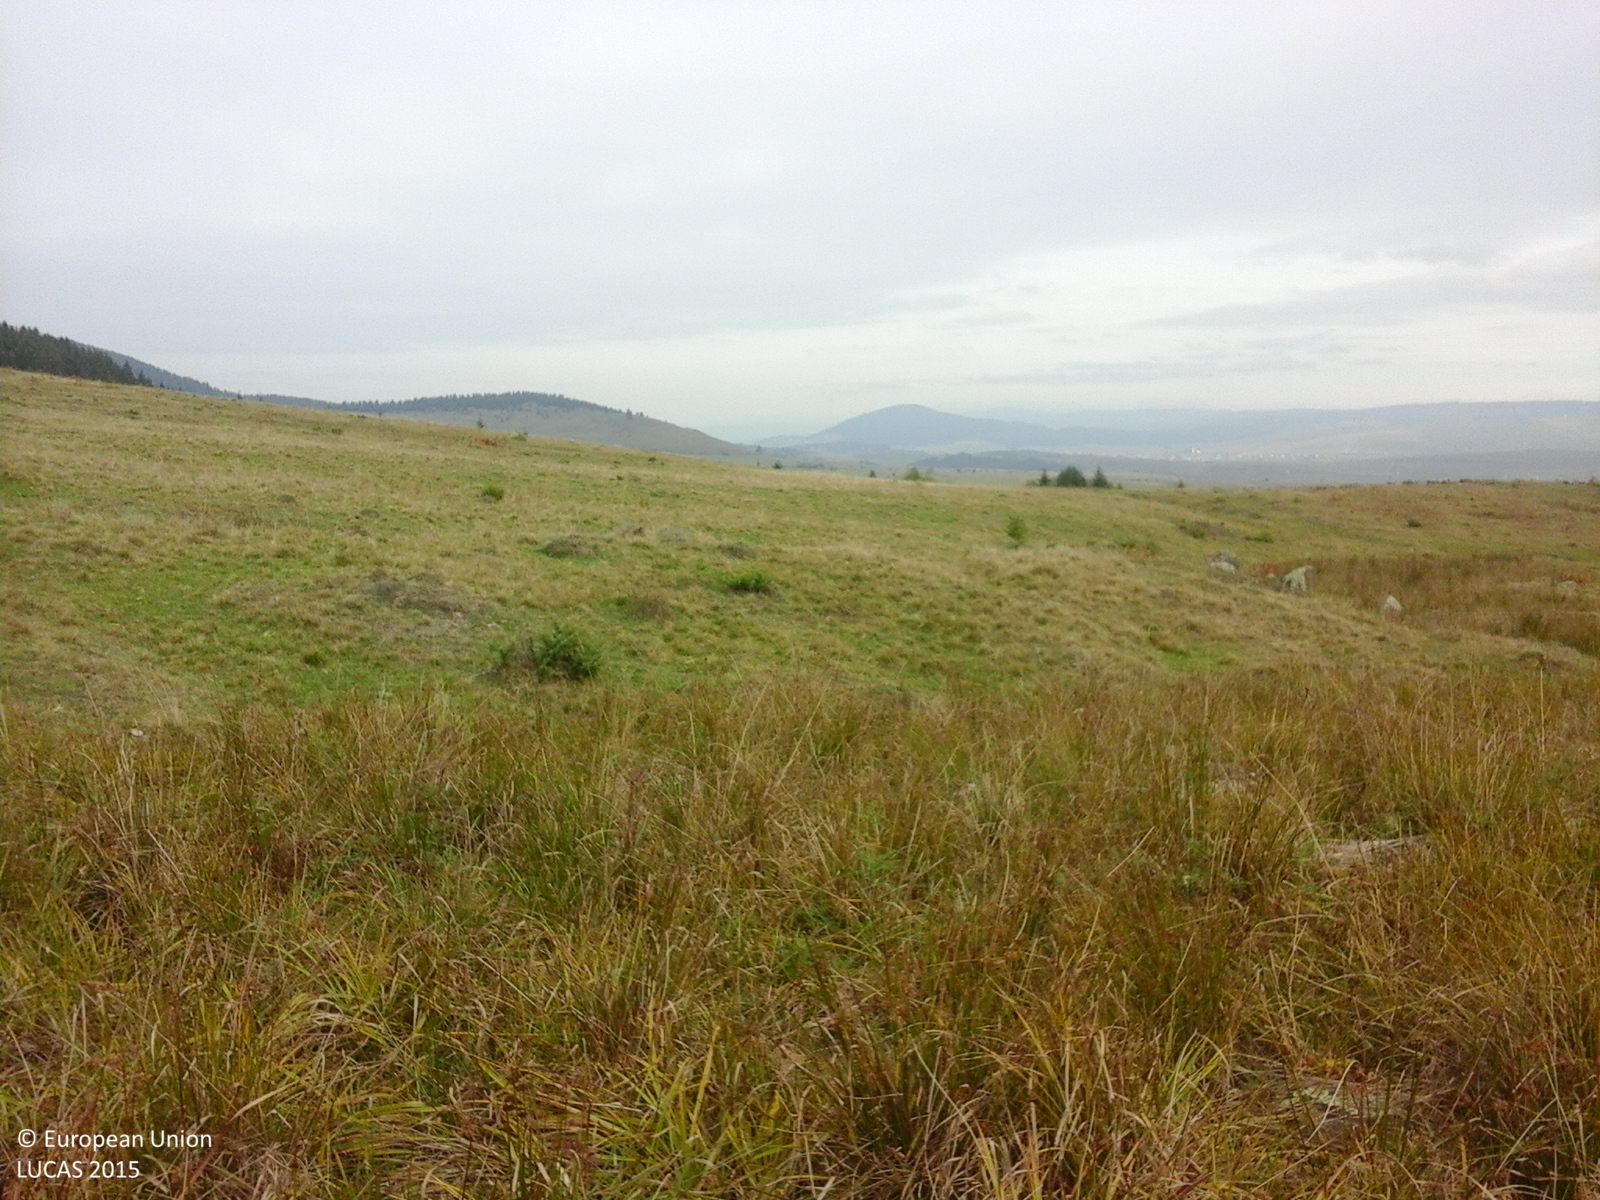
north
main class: Grassland
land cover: Grassland without tree/shrub cover
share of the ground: > 75 %
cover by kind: herbaceous plants 100 %
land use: Agriculture (excluding fallow land and kitchen gardens)
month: October
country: RO
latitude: 46.2852
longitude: 25.8065
